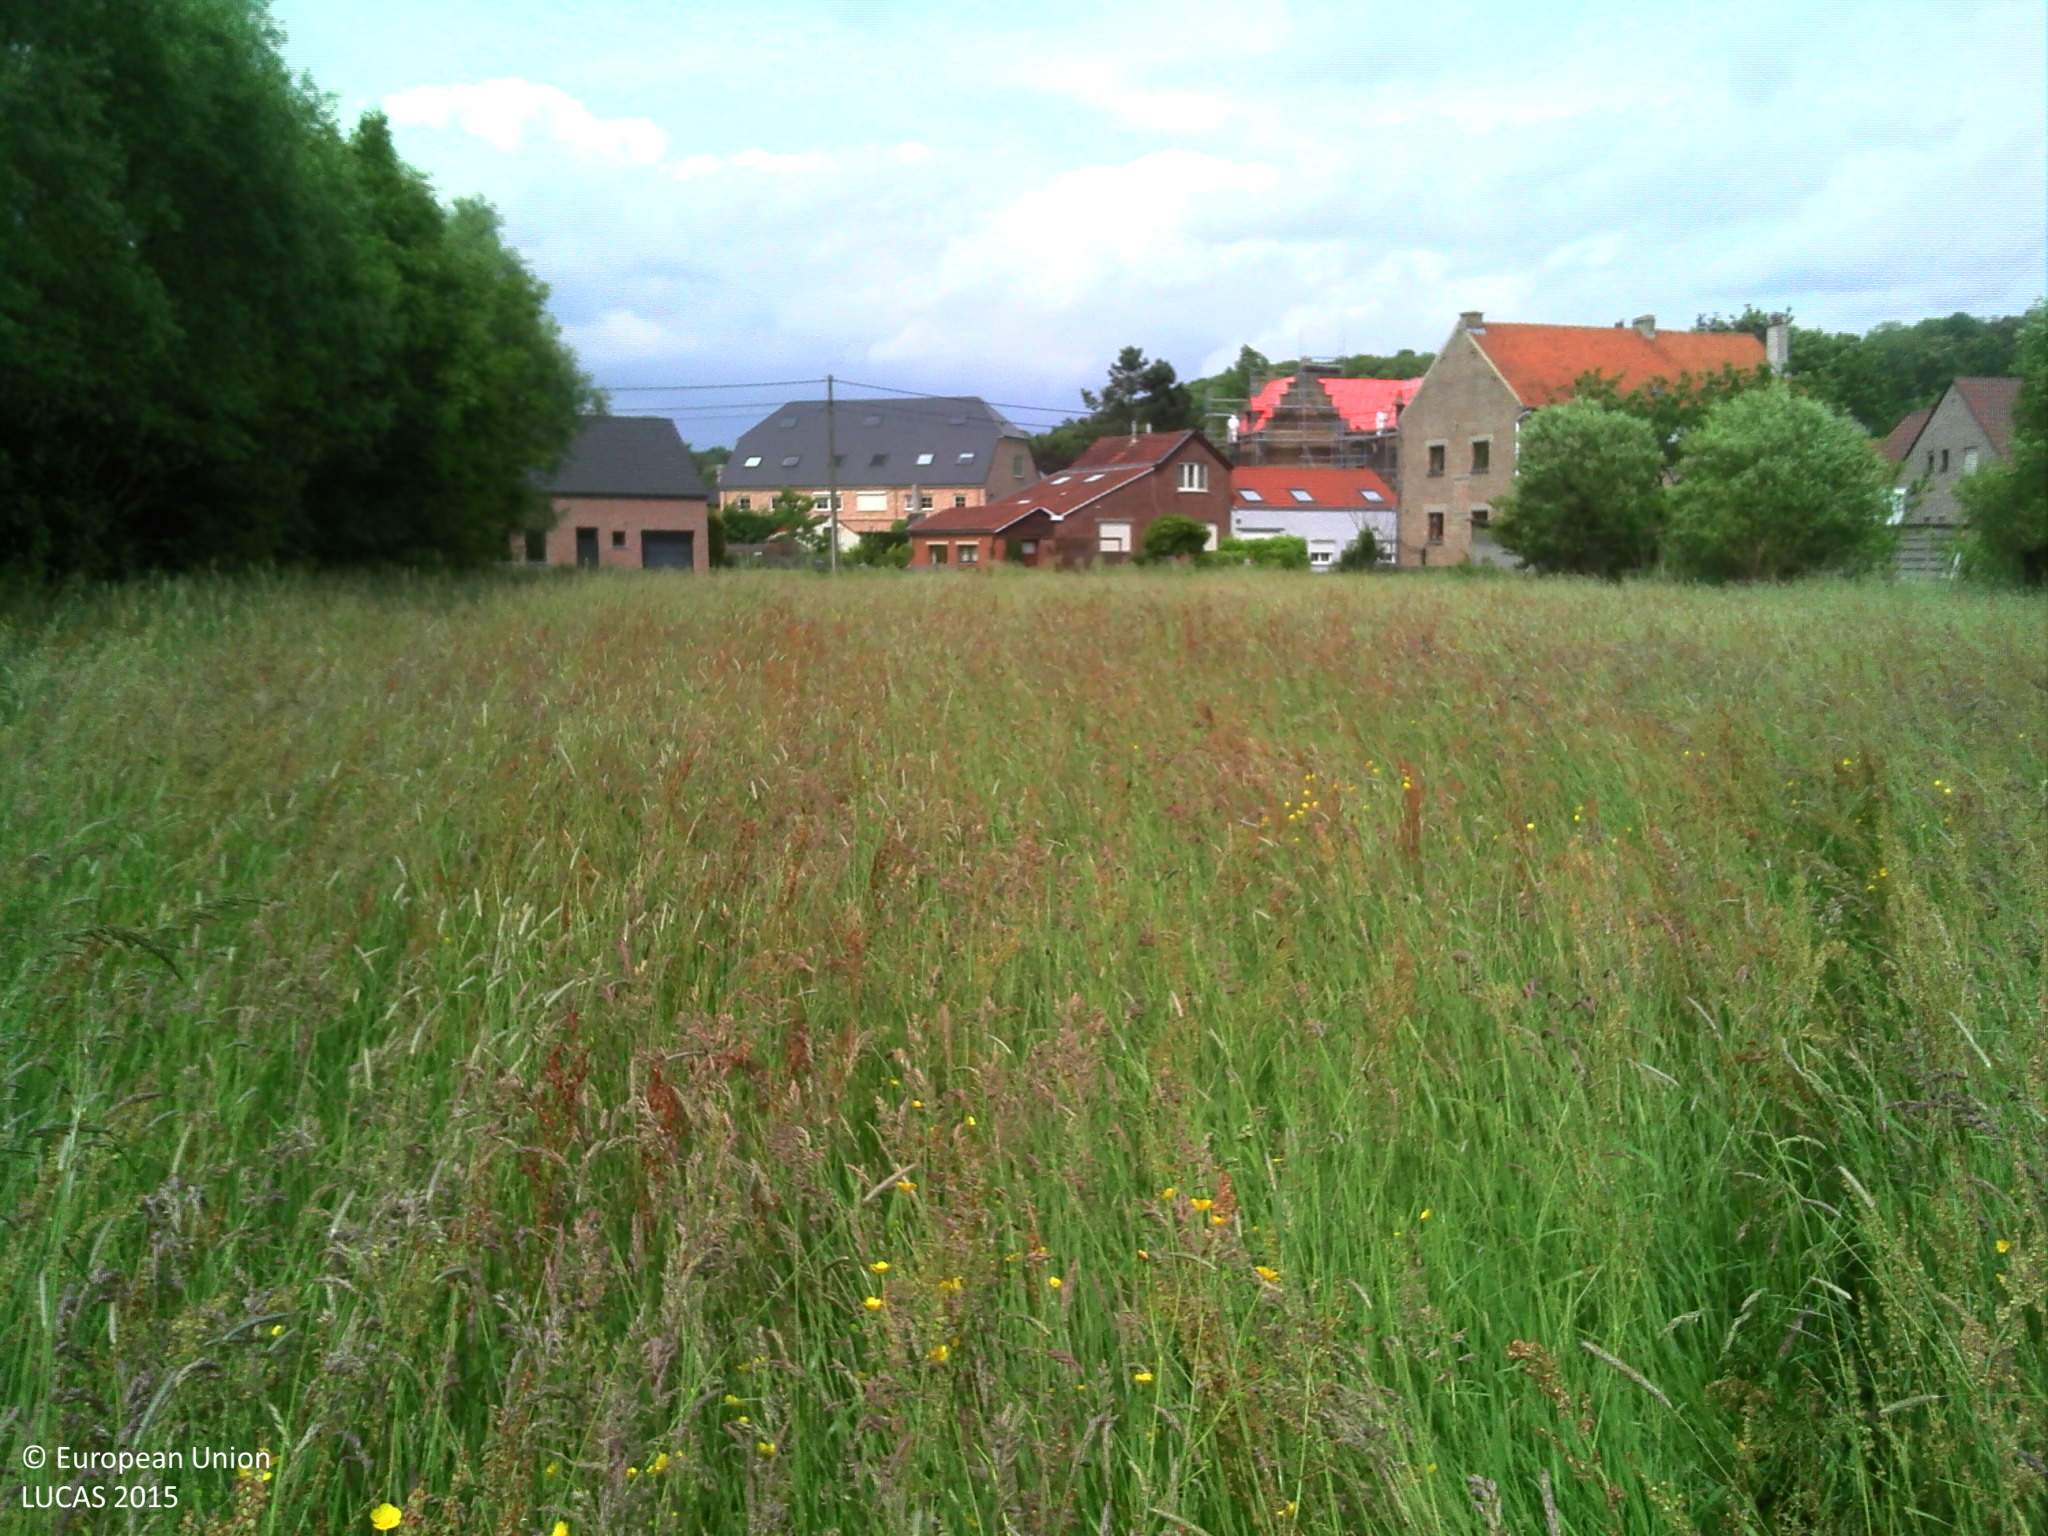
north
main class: Grassland
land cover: Grassland without tree/shrub cover
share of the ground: > 75 %
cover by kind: herbaceous plants 100 %
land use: Agriculture (excluding fallow land and kitchen gardens)
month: May
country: BE
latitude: 50.7974
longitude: 4.6474
